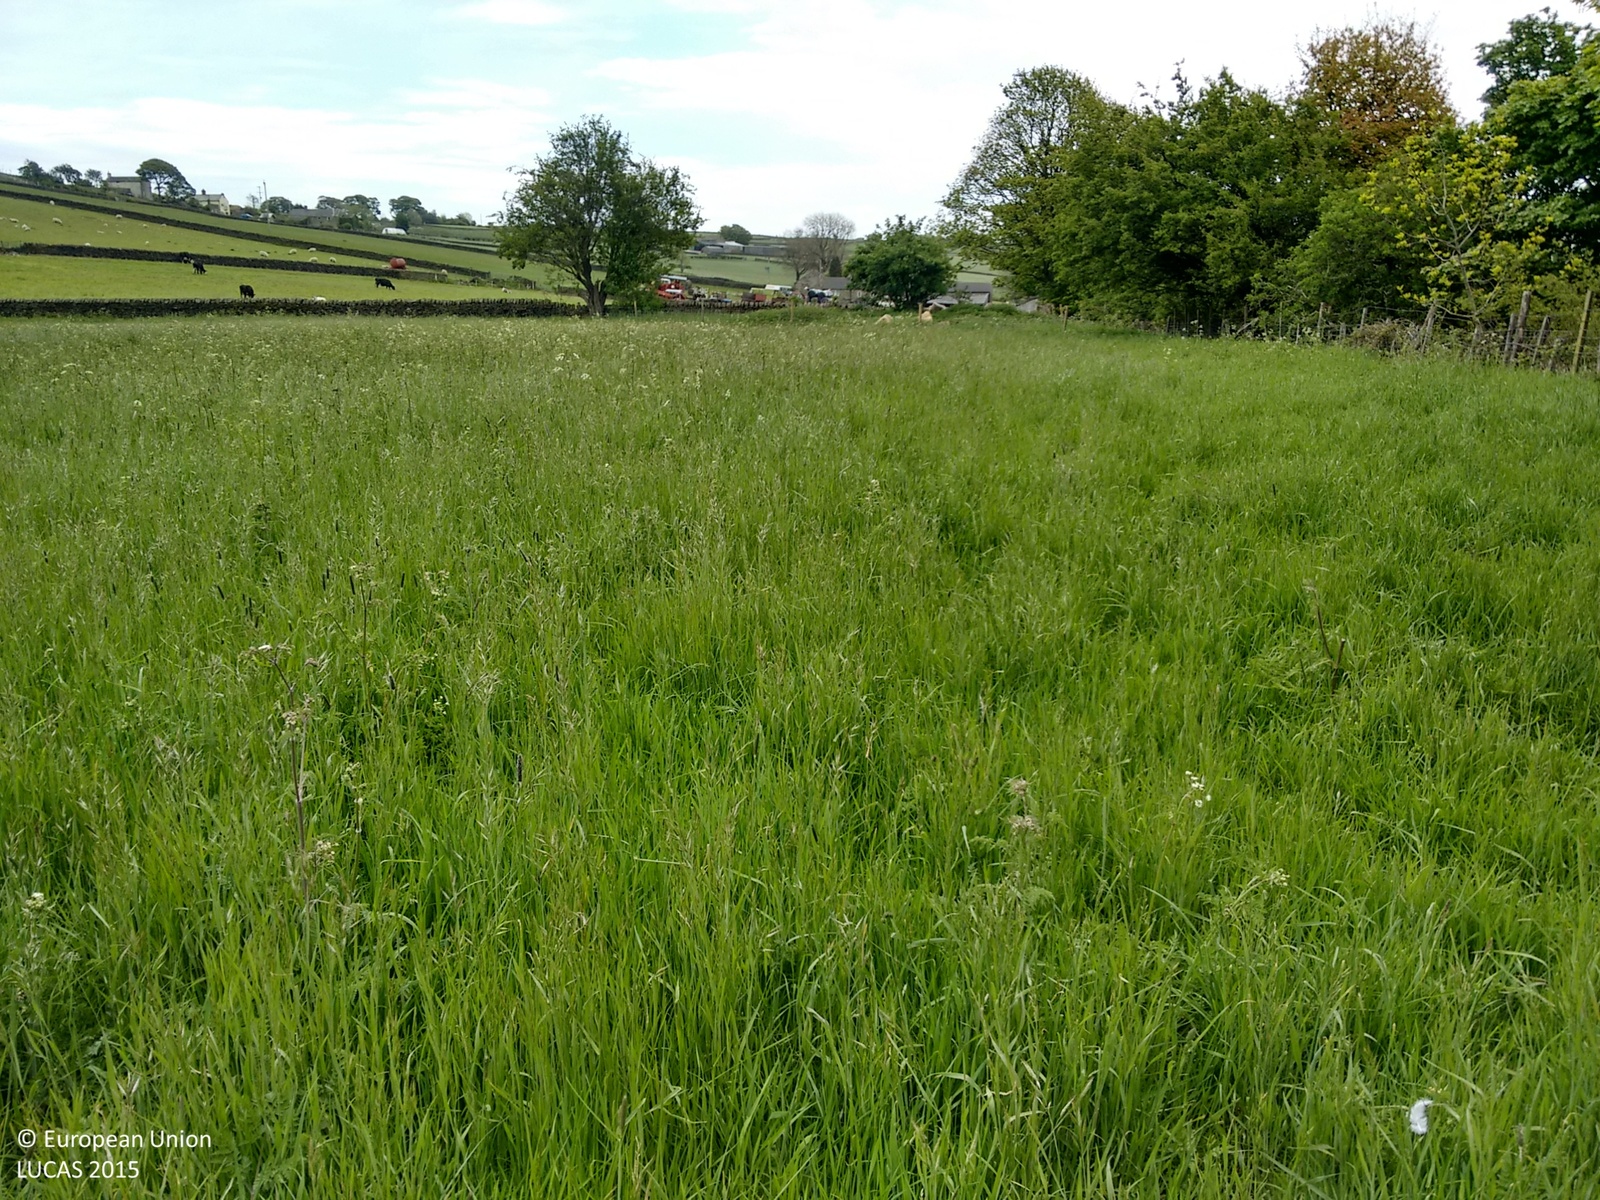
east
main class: Grassland
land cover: Grassland without tree/shrub cover
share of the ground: > 75 %
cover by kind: herbaceous plants 100 %
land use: Agriculture (excluding fallow land and kitchen gardens)
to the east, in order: Grassland without tree/shrub cover; Dry stone walls; Grassland without tree/shrub cover; Dry stone walls; Grassland without tree/shrub cover; Dry stone walls; Grassland without tree/shrub cover
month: May
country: GB
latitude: 53.5157
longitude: -1.5883
